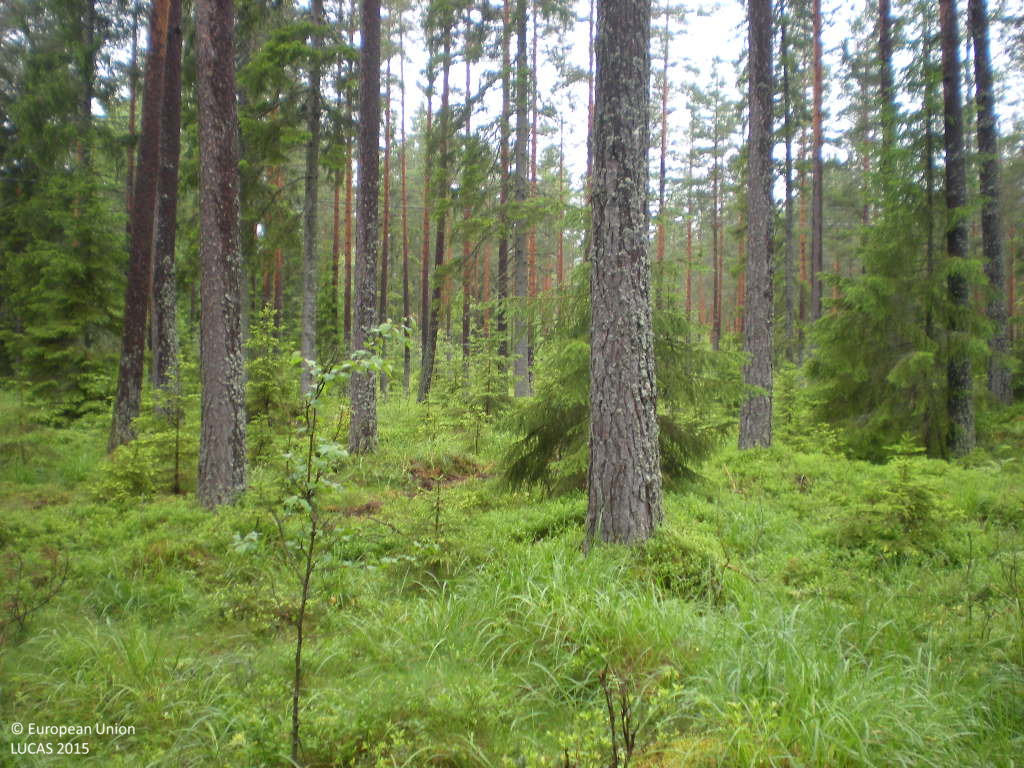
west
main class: Woodland
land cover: Pine dominated coniferous woodland
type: boreal forest
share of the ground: 50 - 75 %
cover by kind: coniferous forest trees 65 %, herbaceous plants 20 %, shrubs 10 %, lichens and mosses 5 %
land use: Forestry
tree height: > 5 m
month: June
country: SE
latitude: 60.3407
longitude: 17.8738
